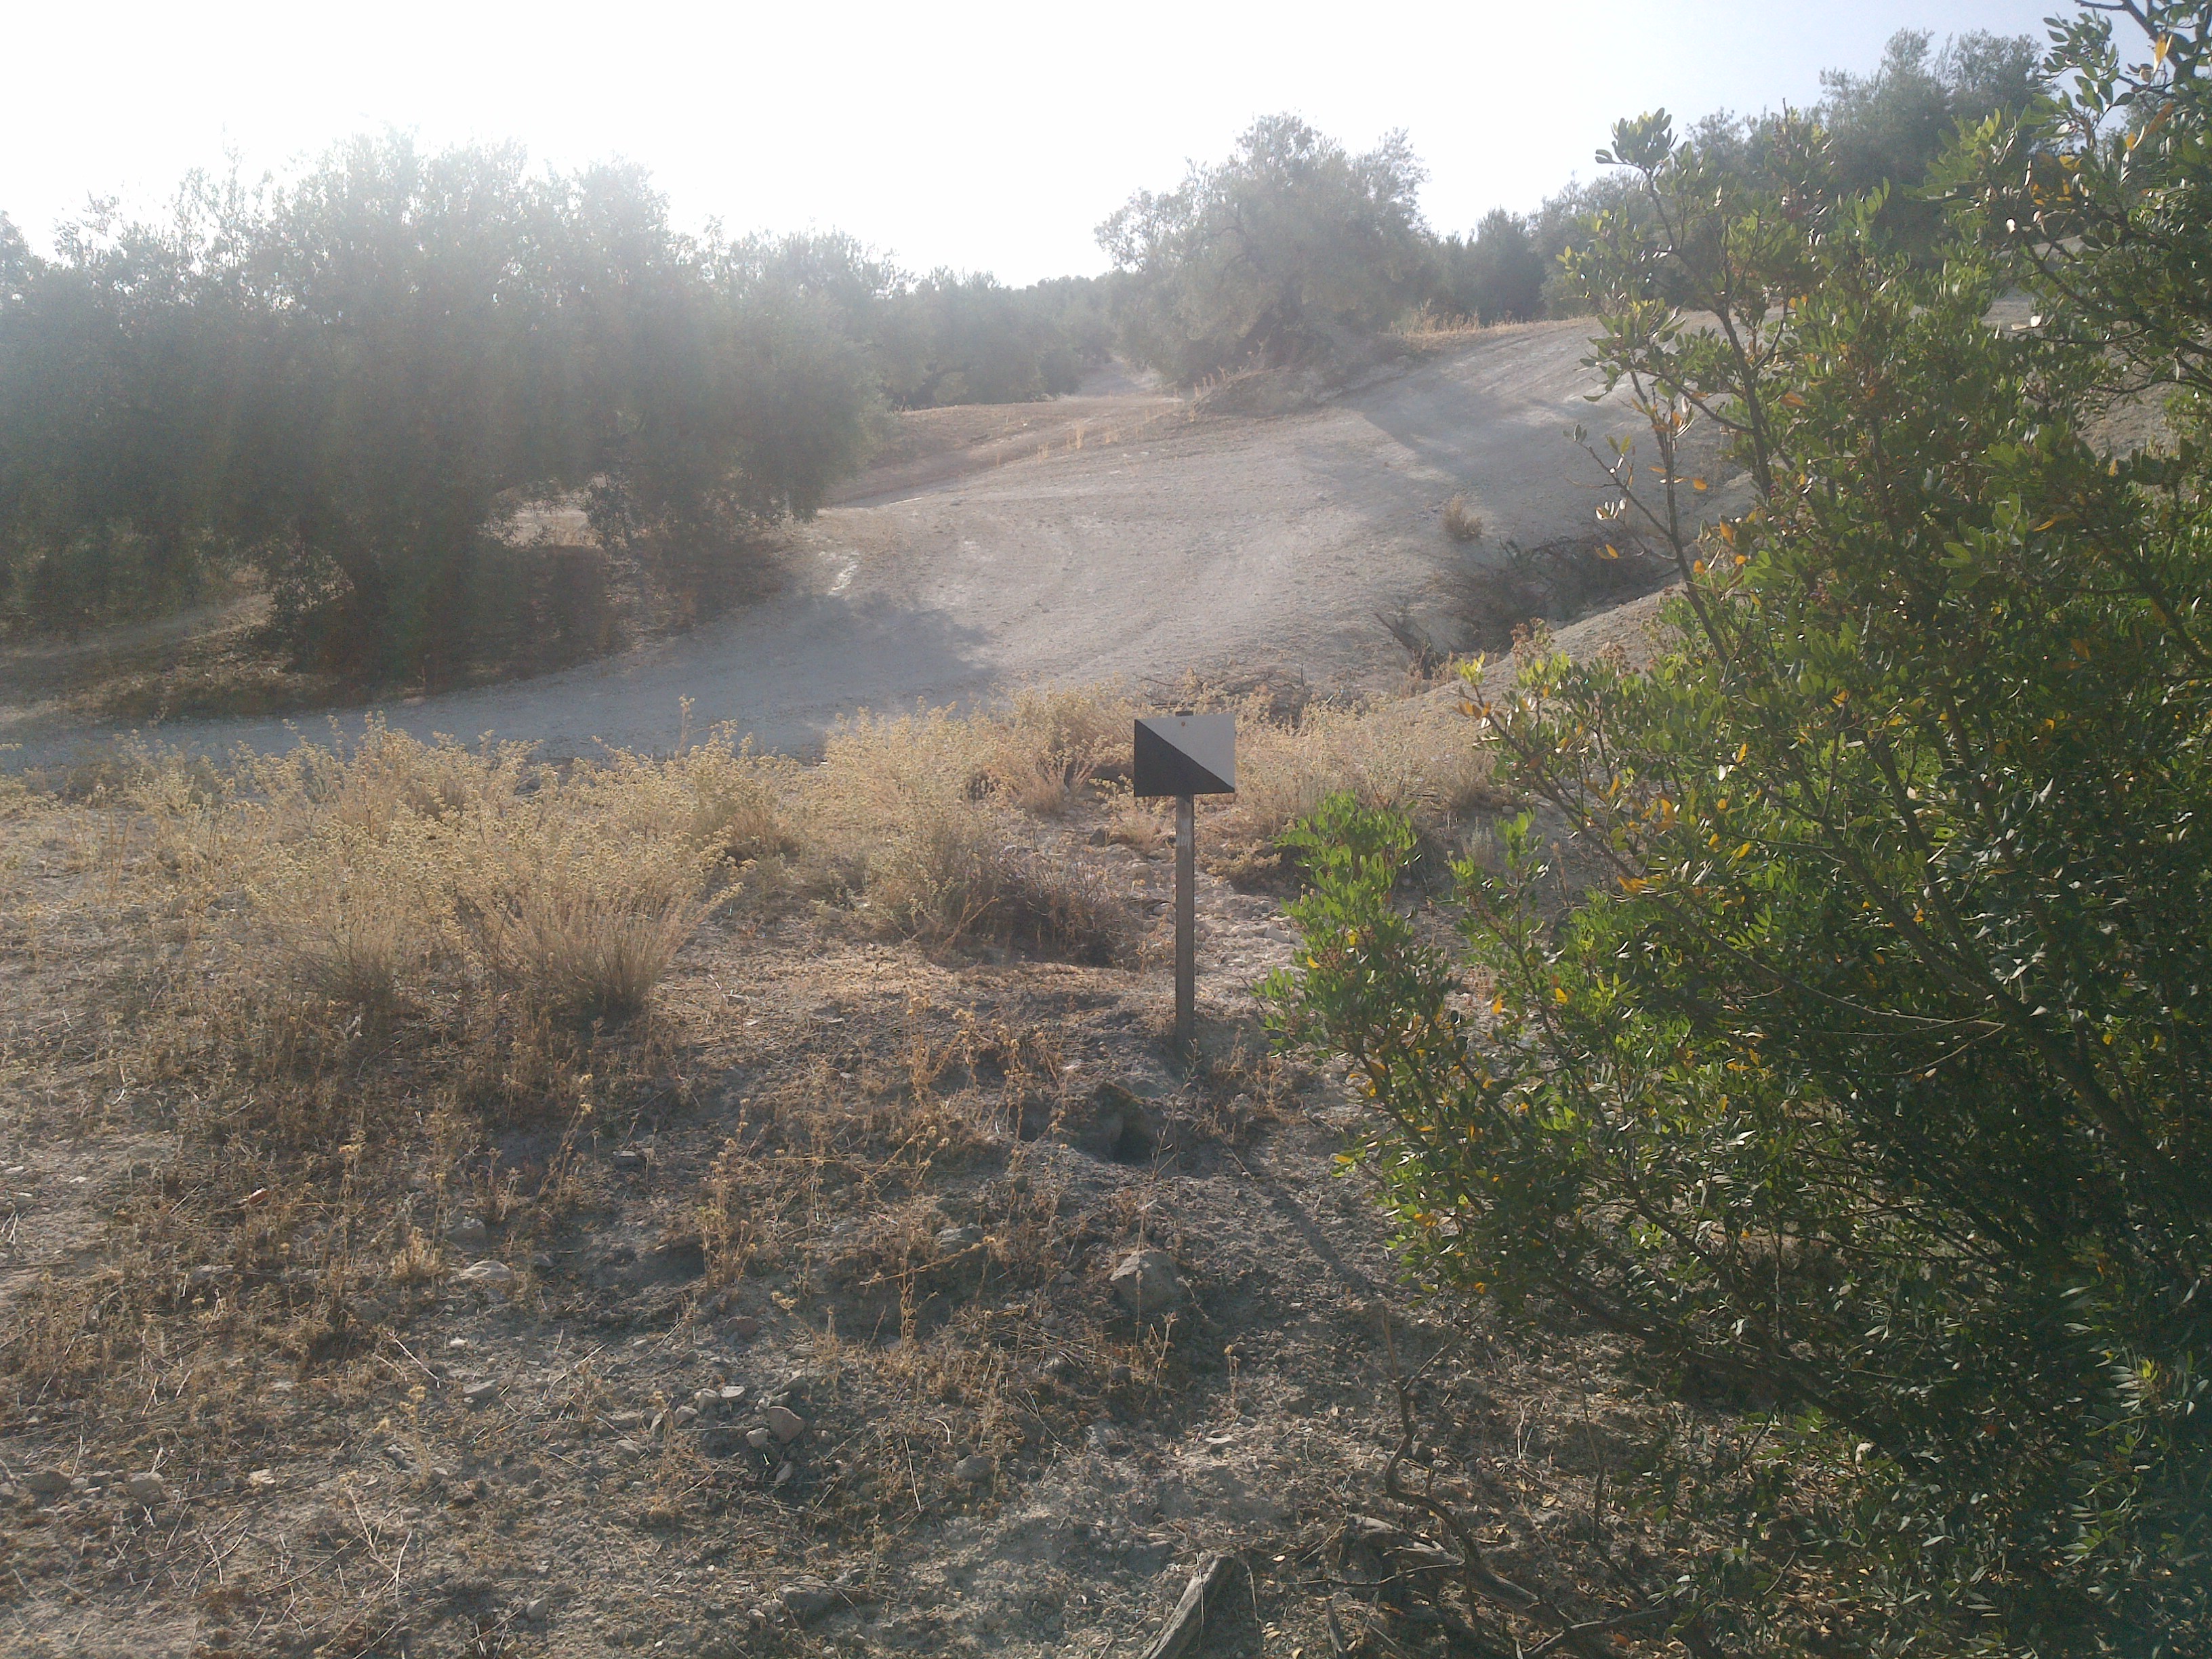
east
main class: Shrubland
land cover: Shrubland without tree cover
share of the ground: 50 - 75 %
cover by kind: shrubs 60 %, herbaceous plants 20 %, unconsolidated bare surface 20 %
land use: Semi-natural and natural areas not in use
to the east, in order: Shrubland without tree cover; Olive groves; Electric lines; Olive groves
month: July
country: ES
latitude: 37.3602
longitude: -4.5332
